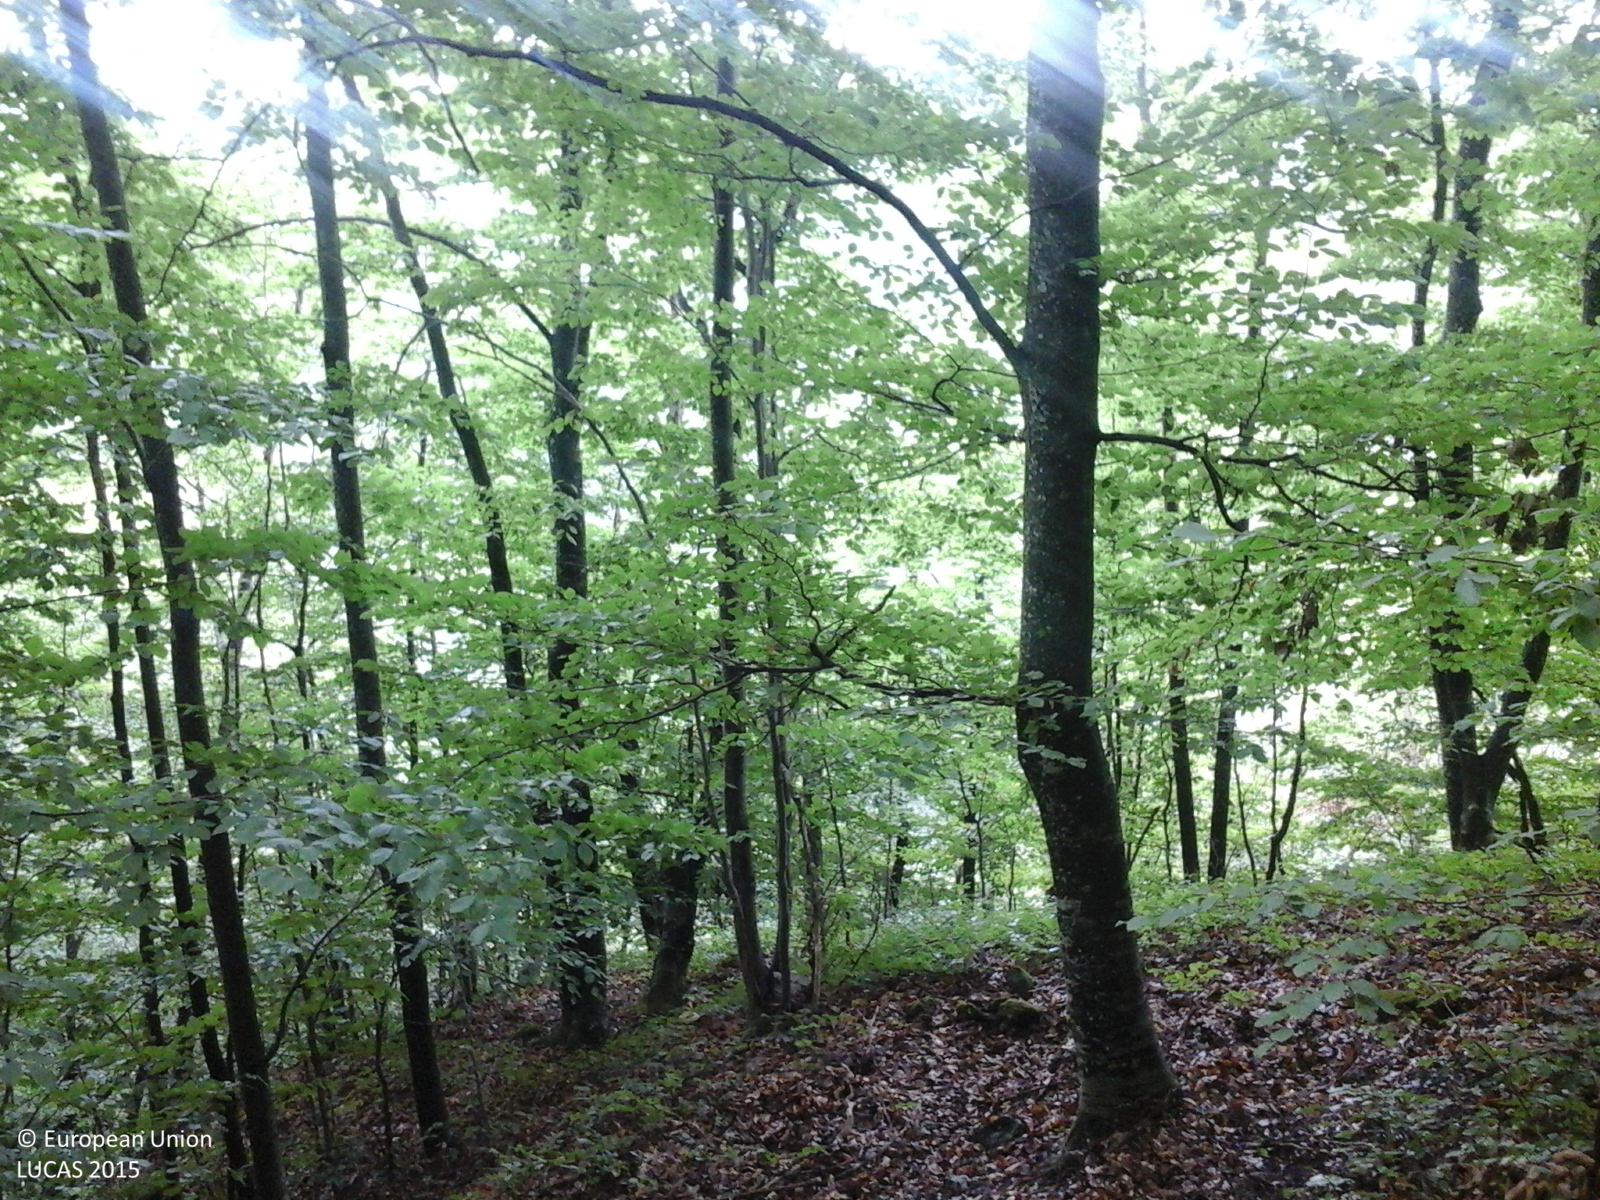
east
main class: Woodland
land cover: Broadleaved woodland
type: mesophytic deciduous forest
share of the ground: > 75 %
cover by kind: broadleaved forest trees 100 %
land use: Forestry
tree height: > 5 m
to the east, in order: Broadleaved woodland; Artificial constructions in urban areas; Inland fresh running water; Fences; Other fruit trees and berries; Fences; Rocks and stones; Paved roads, cycling and walking lanes; Artificial constructions; Other mixed woodland
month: September
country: RO
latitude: 46.9150
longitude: 22.5948
